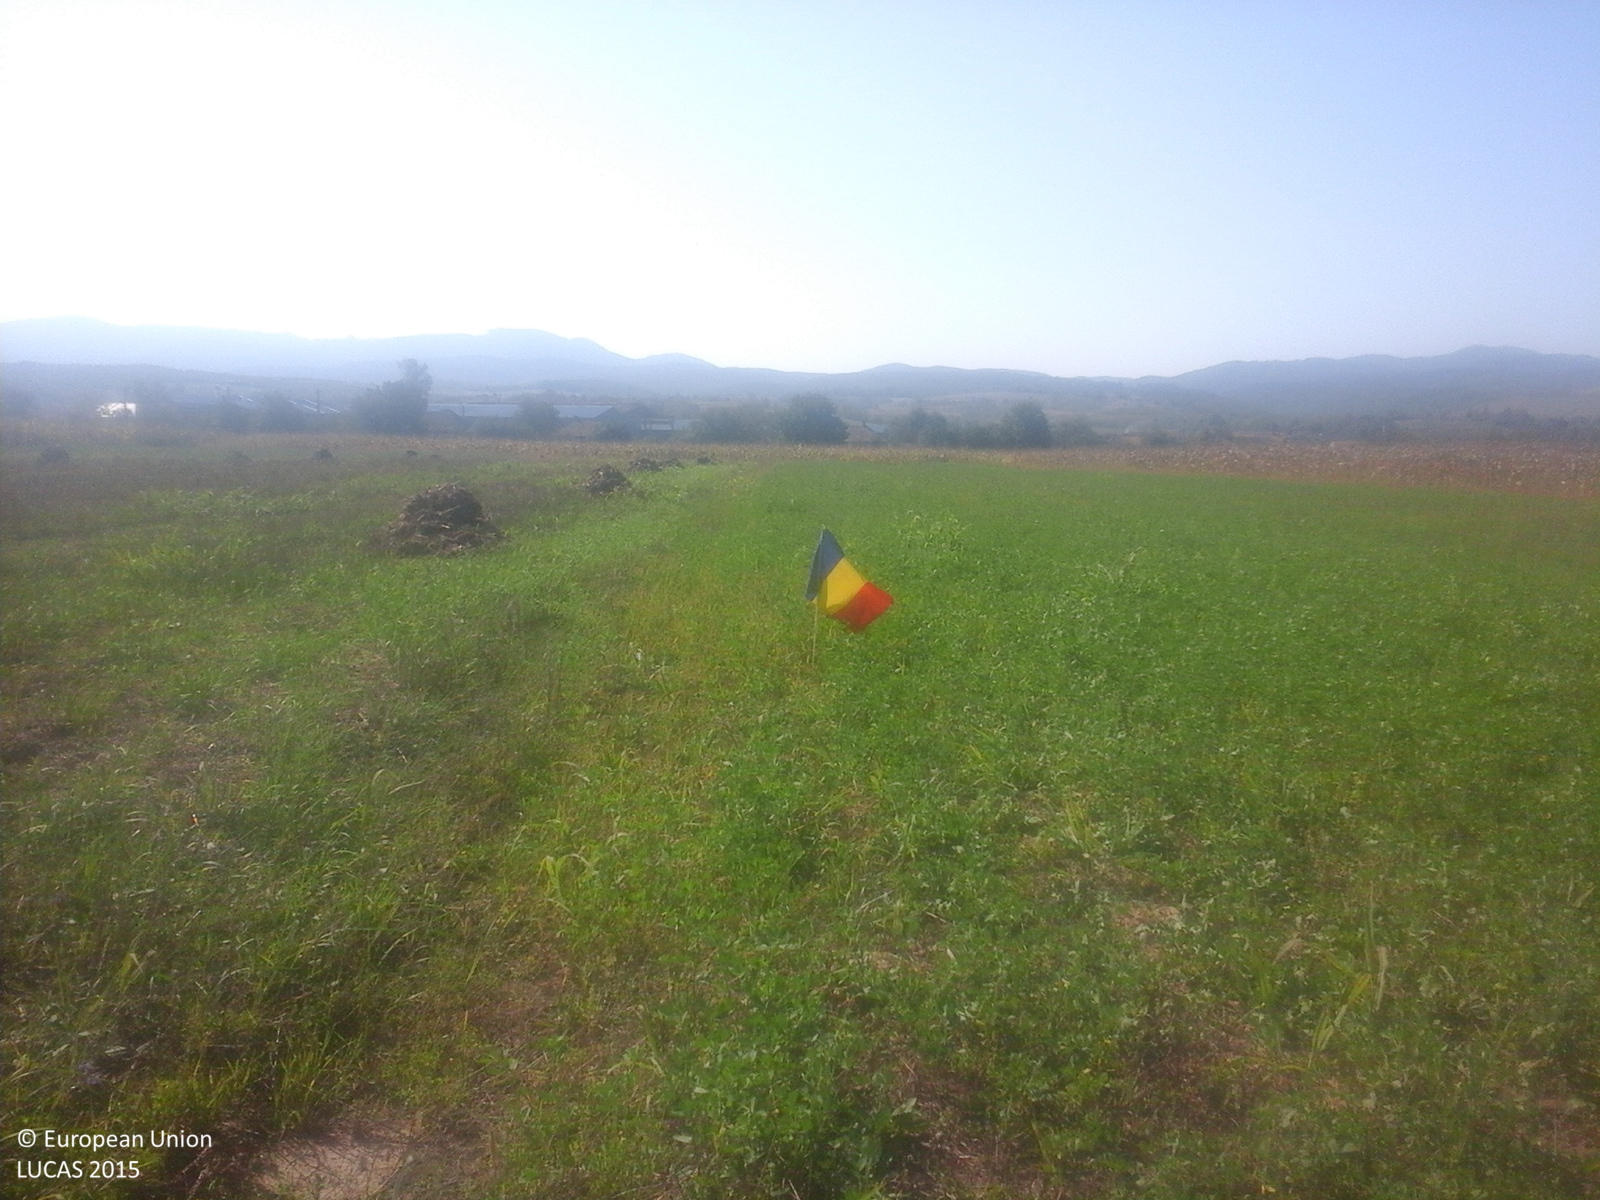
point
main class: Cropland
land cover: Lucerne
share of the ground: > 75 %
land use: Agriculture (excluding fallow land and kitchen gardens)
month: September
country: RO
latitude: 46.6793
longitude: 22.2726
